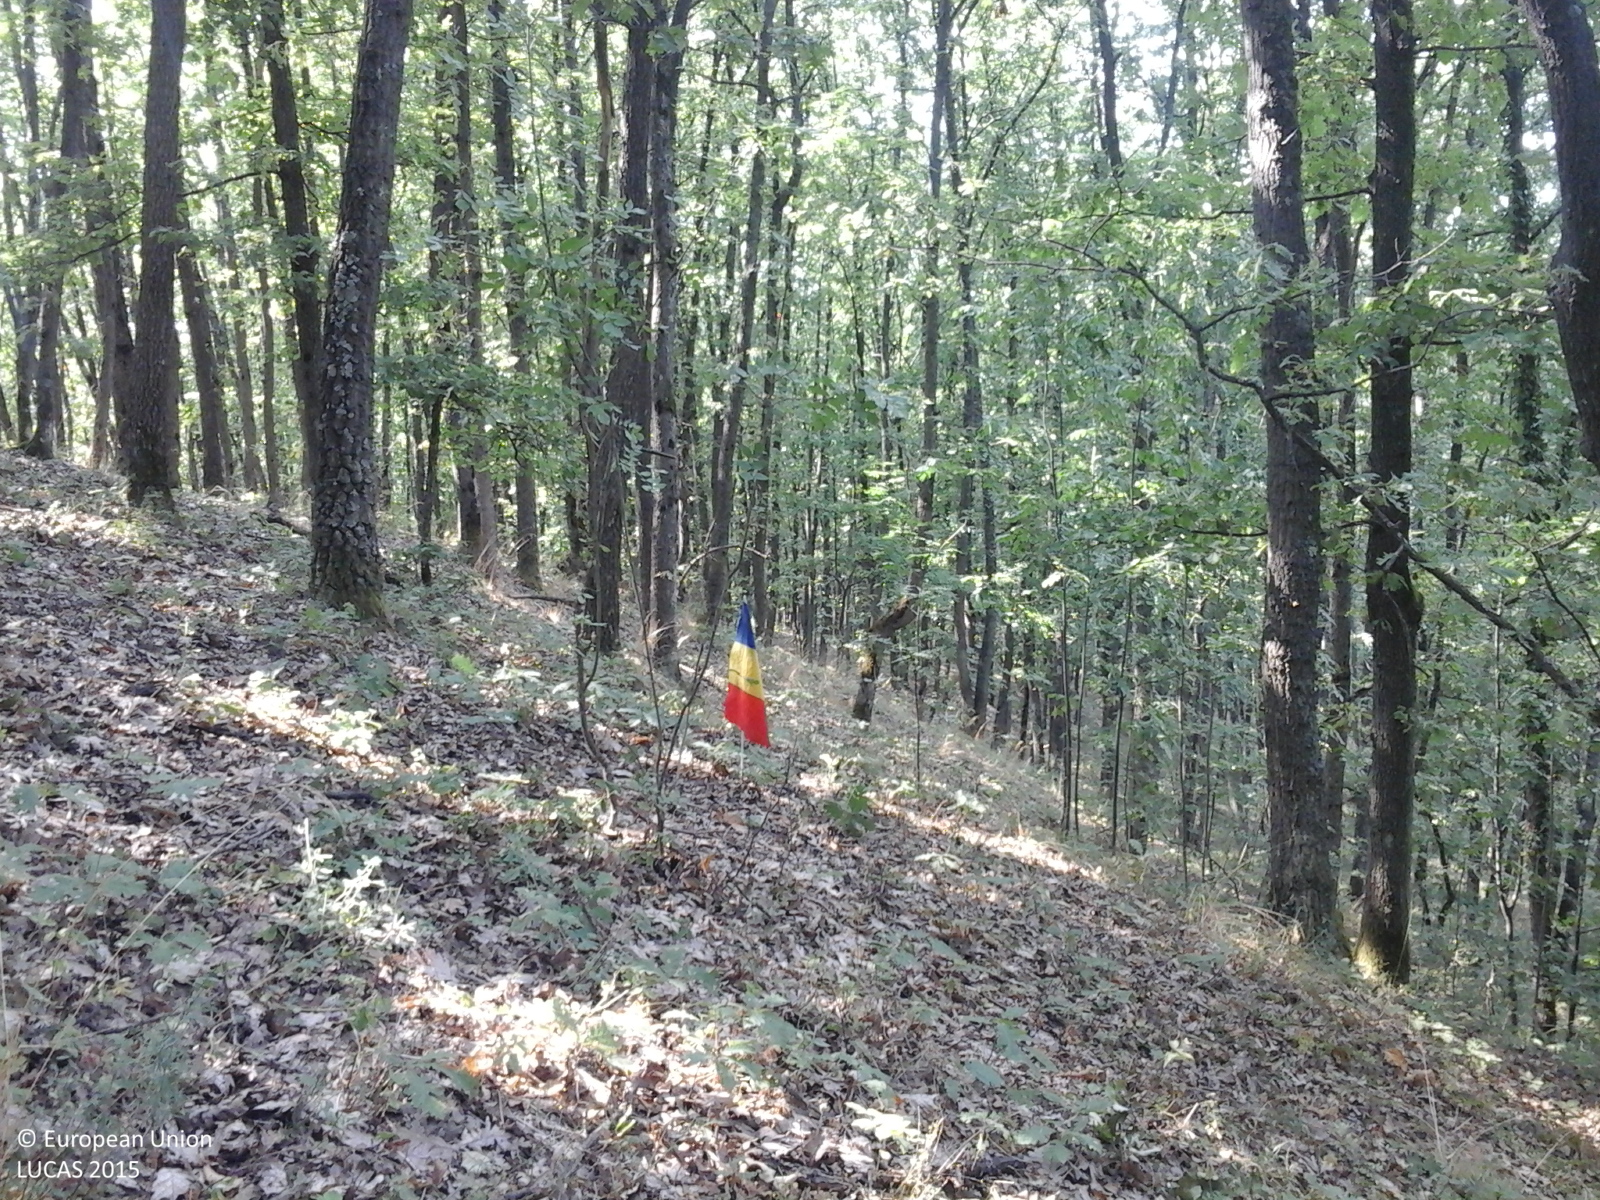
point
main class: Woodland
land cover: Broadleaved woodland
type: acidophilous oak and oak-birch forest
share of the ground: > 75 %
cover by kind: broadleaved forest trees 100 %
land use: Forestry
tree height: > 5 m
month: August
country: RO
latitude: 44.6954
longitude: 23.8537
